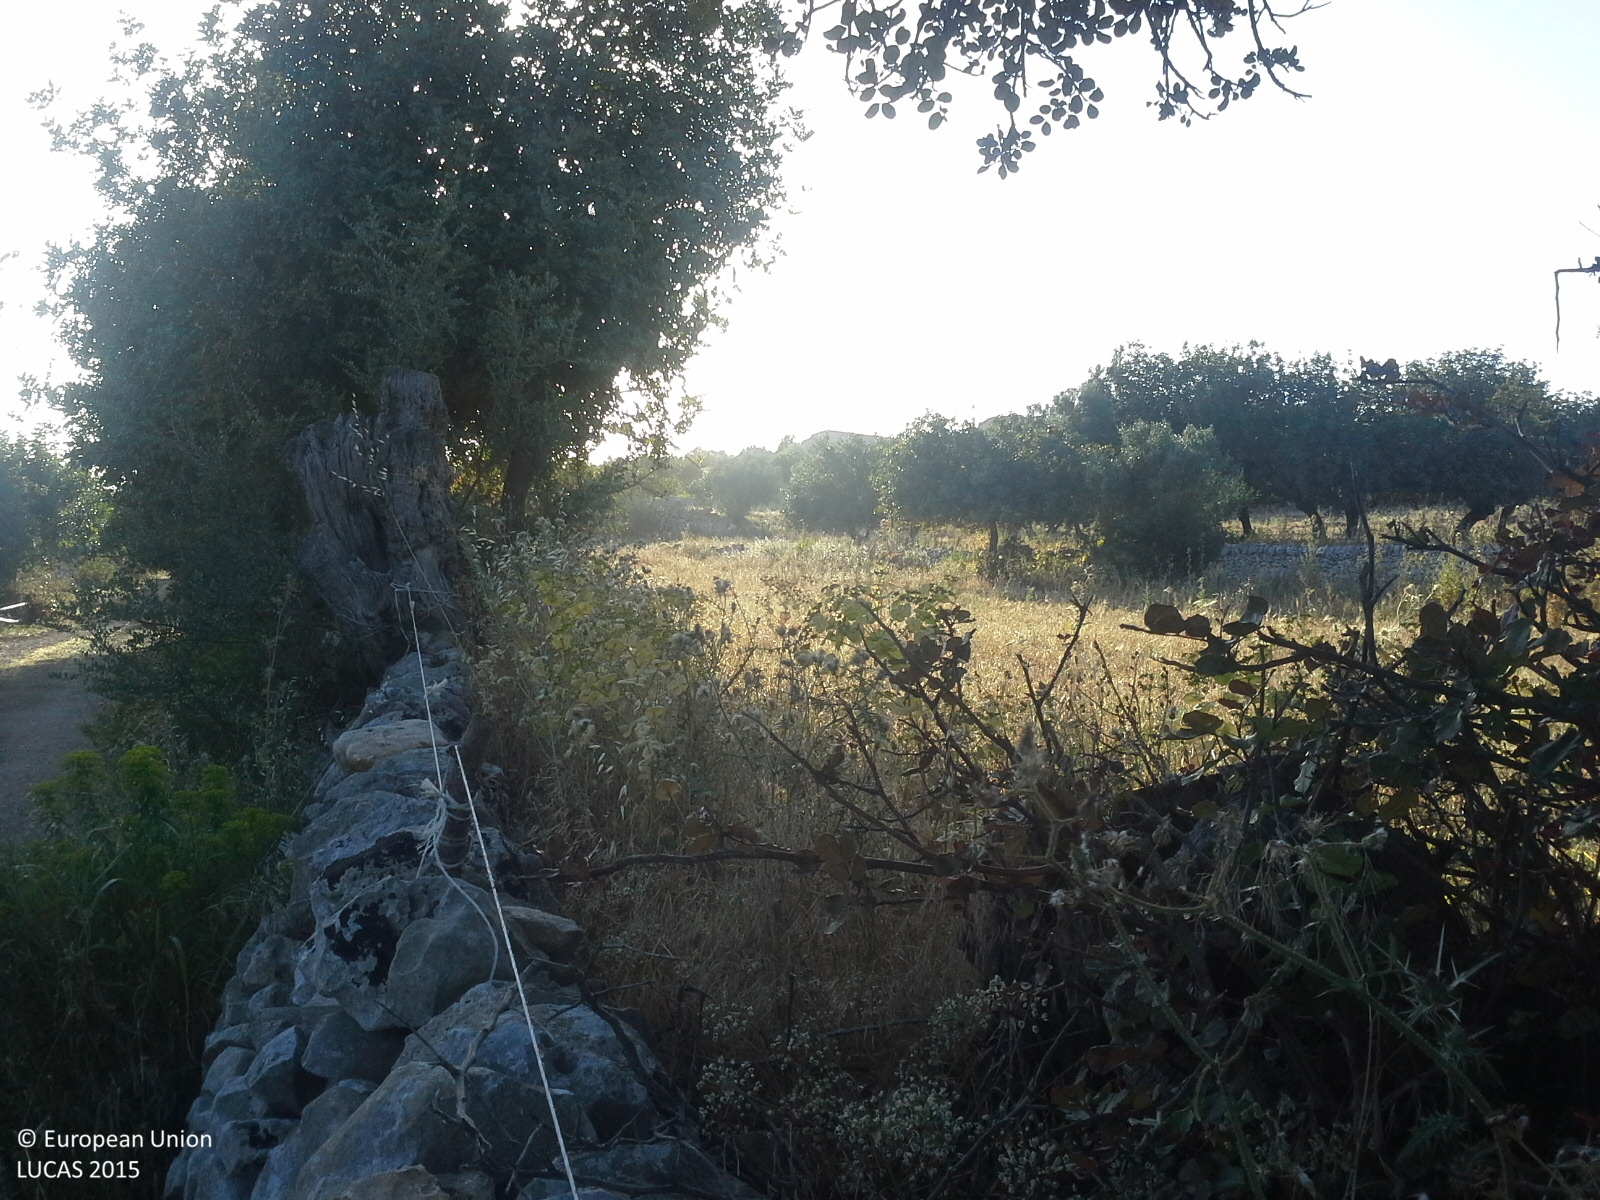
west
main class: Cropland
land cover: Permanent industrial crops
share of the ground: > 75 %
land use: Agriculture (excluding fallow land and kitchen gardens)
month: May
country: IT
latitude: 36.7866
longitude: 14.8578
